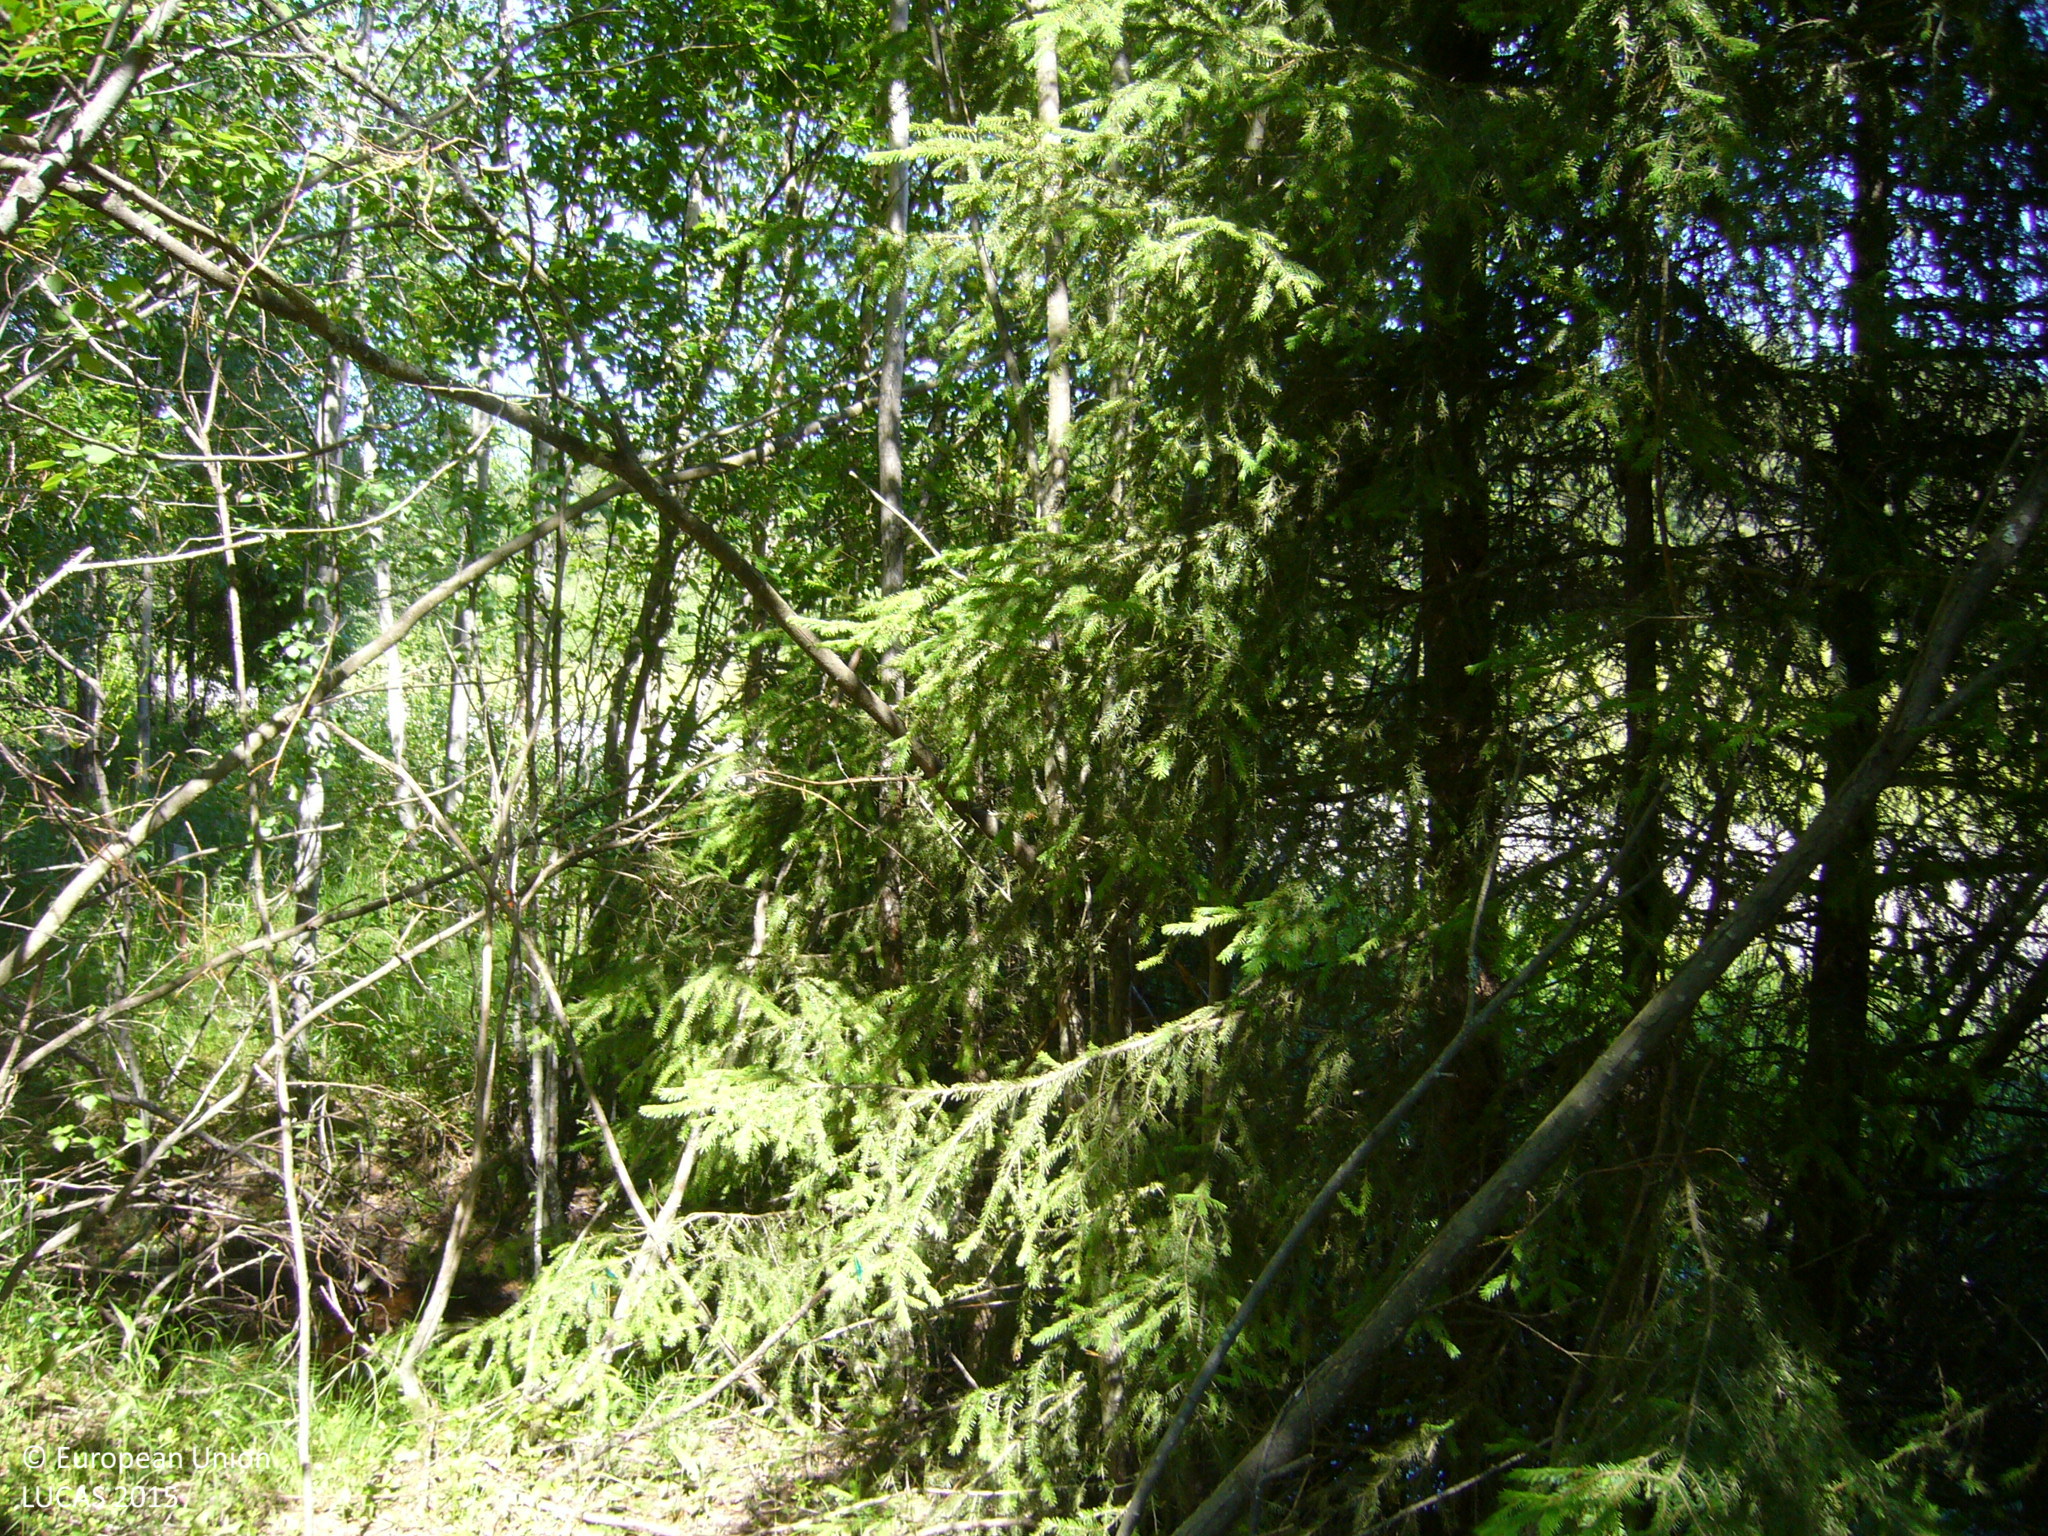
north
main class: Woodland
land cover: Other mixed woodland
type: boreal forest
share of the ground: > 75 %
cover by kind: broadleaved forest trees 50 %, coniferous forest trees 30 %, shrubs 20 %
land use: Forestry
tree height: > 5 m
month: July
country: FI
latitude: 63.3464
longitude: 25.9179
